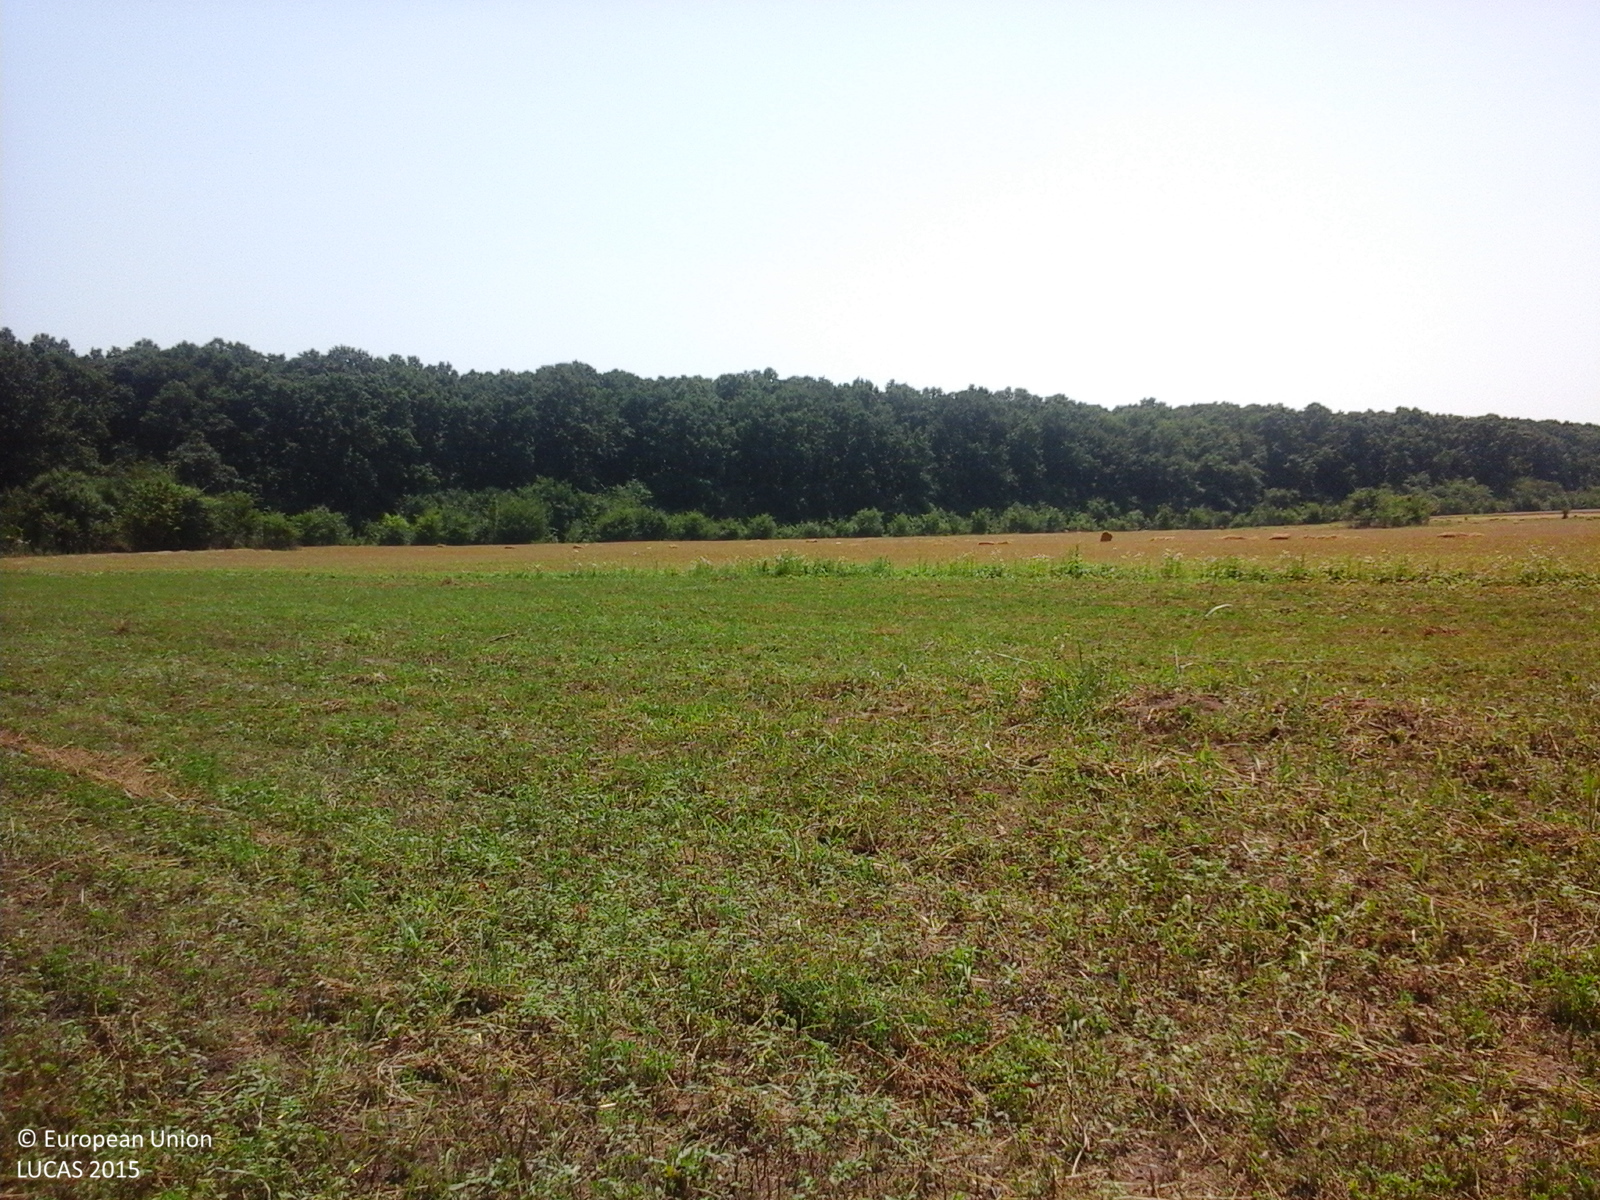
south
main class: Cropland
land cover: Lucerne
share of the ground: 10 - 25 %
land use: Agriculture (excluding fallow land and kitchen gardens)
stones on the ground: < 10 %
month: July
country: RO
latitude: 44.5646
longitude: 25.9032
